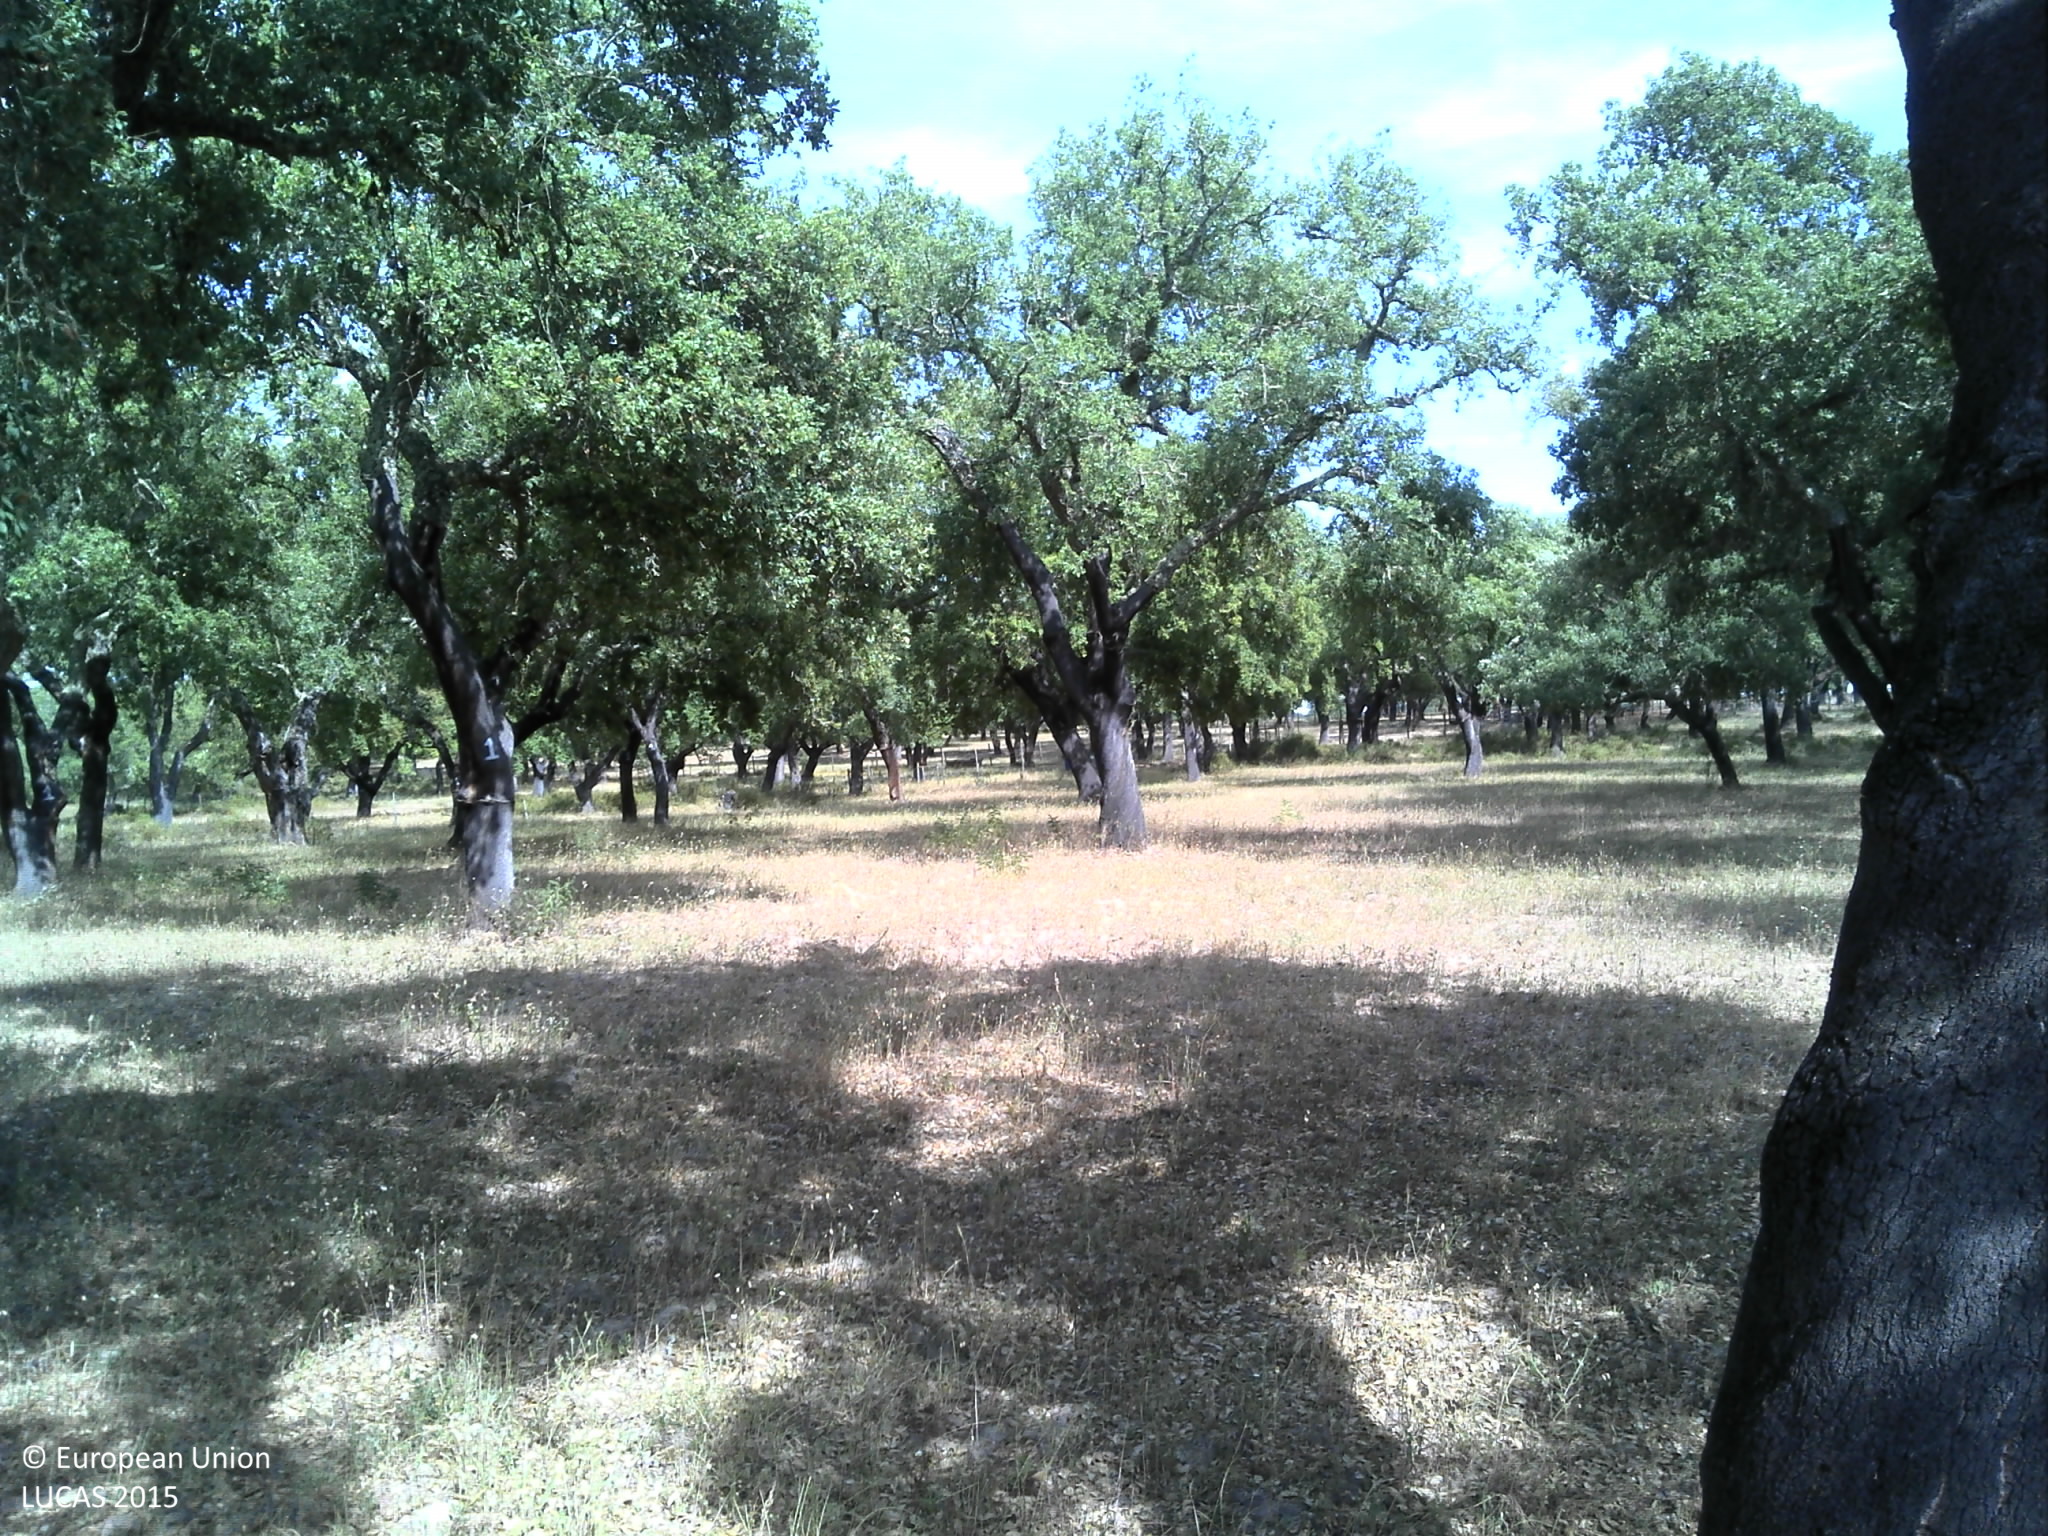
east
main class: Woodland
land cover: Broadleaved woodland
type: broadleaved evergreen forest
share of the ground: 50 - 75 %
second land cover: Grassland without tree/shrub cover
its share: 10 - 25 %
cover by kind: broadleaved forest trees 60 %, herbaceous plants 20 %, unconsolidated bare surface 20 %
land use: Forestry
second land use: Agriculture (excluding fallow land and kitchen gardens)
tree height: > 5 m
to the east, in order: Broadleaved woodland; Grassland without tree/shrub cover; Tracks; Fences; Broadleaved woodland; Fences; Broadleaved woodland
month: May
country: PT
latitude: 38.0694
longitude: -8.3819
